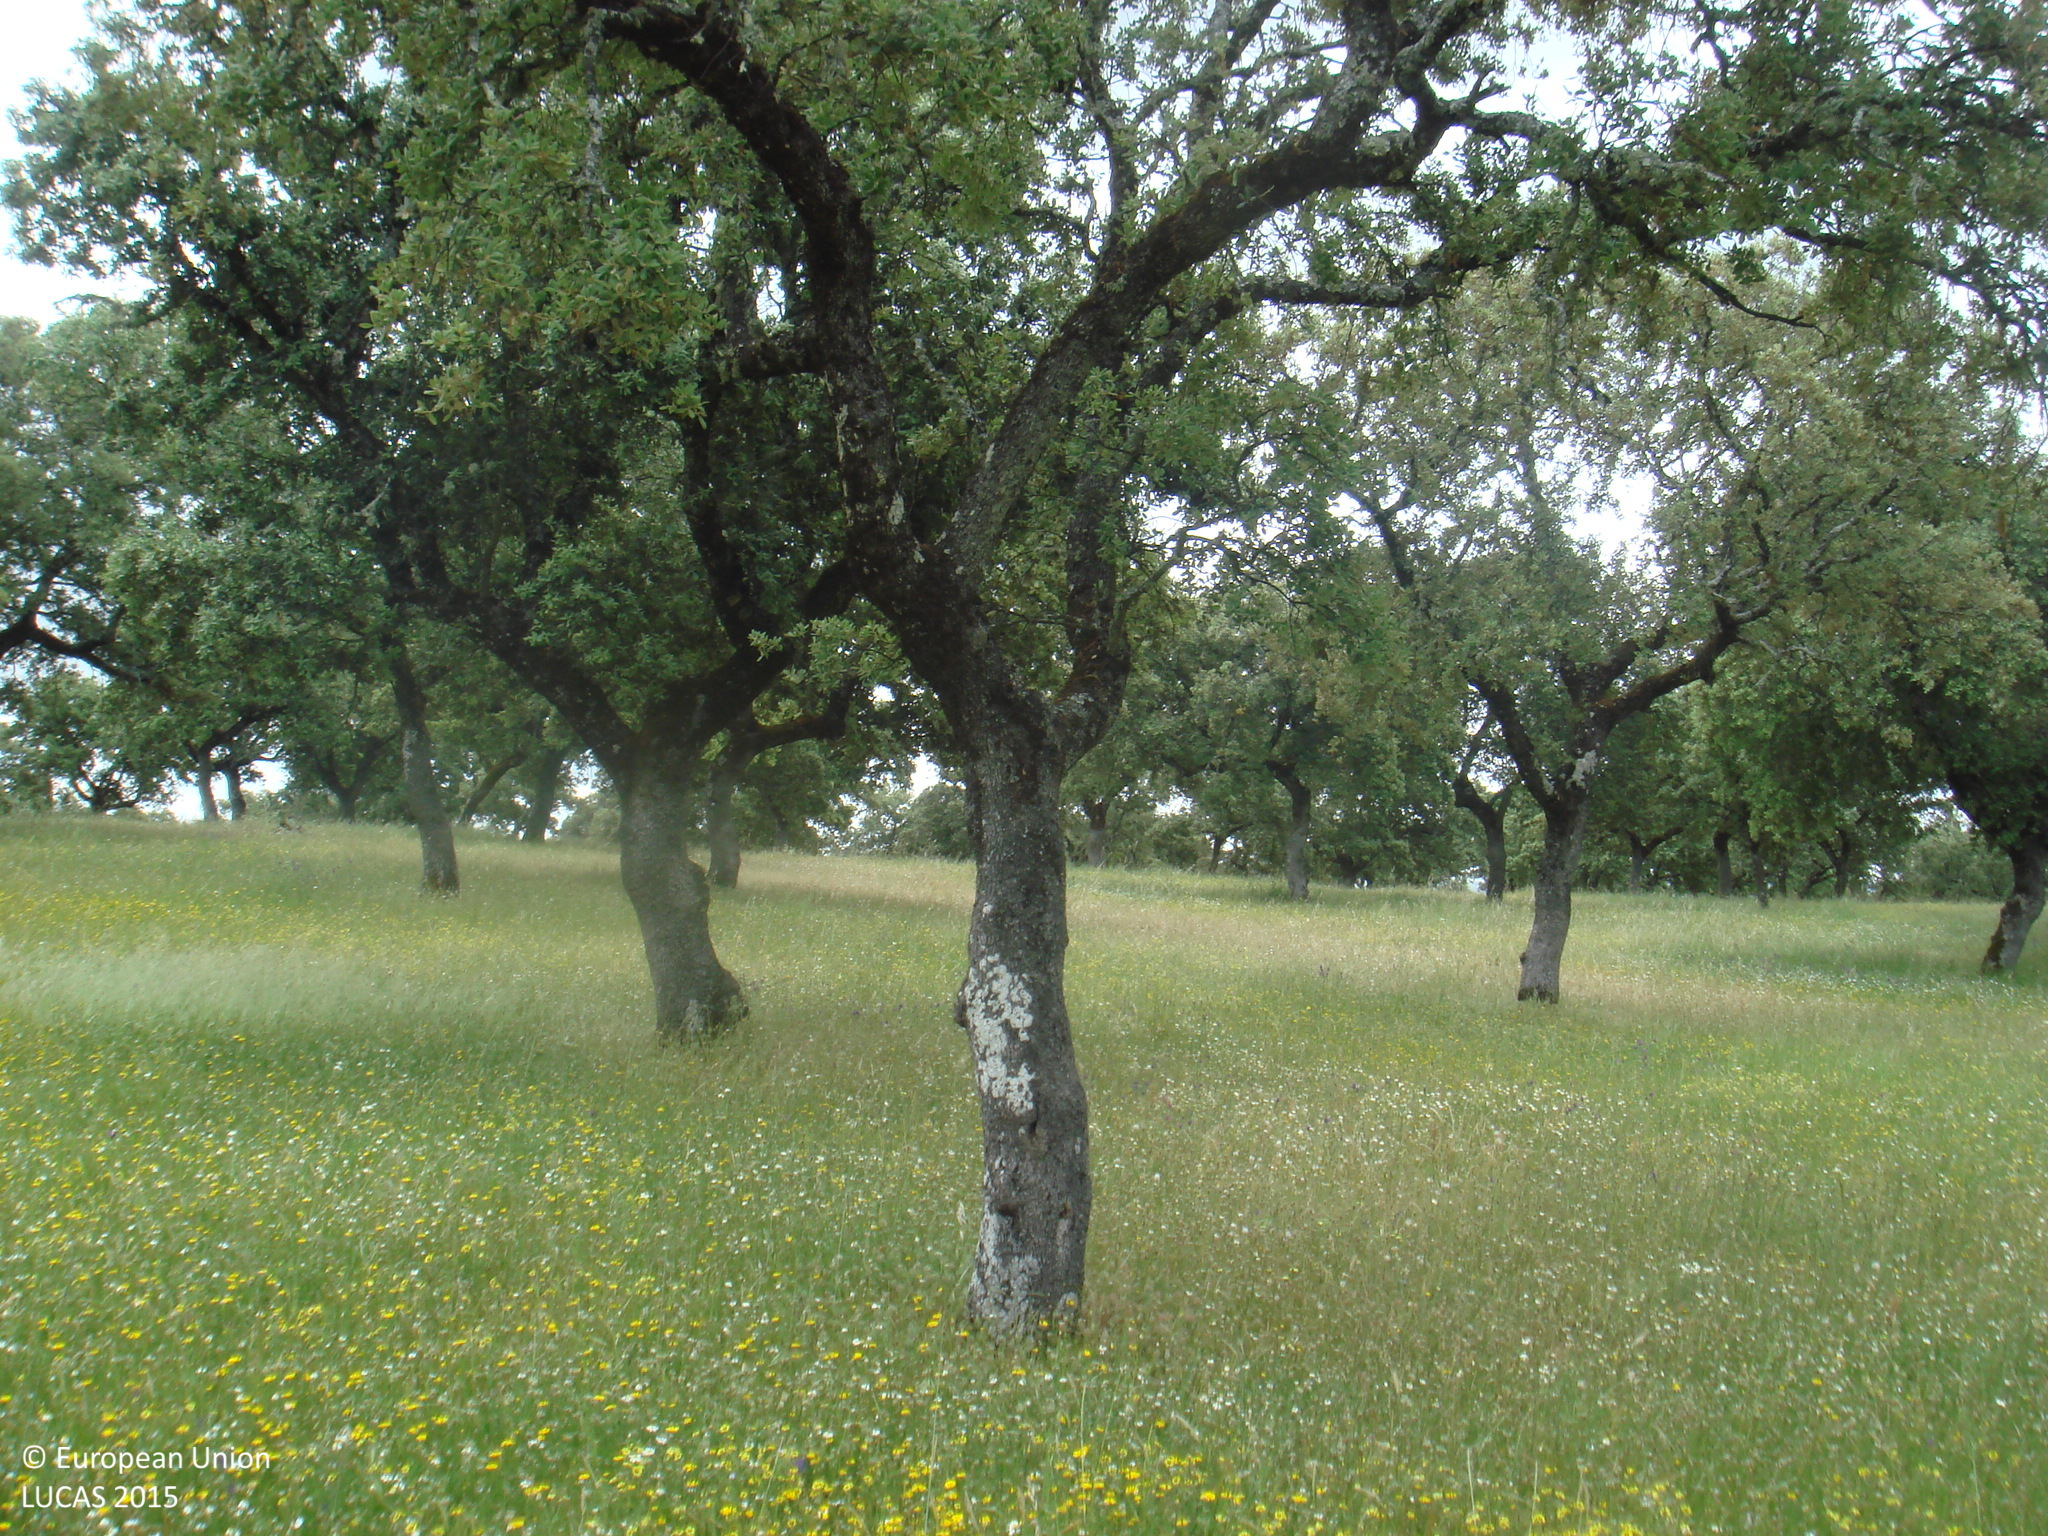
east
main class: Woodland
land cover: Broadleaved woodland
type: broadleaved evergreen forest
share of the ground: 50 - 75 %
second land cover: Grassland without tree/shrub cover
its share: > 75 %
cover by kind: broadleaved forest trees 50 %, herbaceous plants 50 %
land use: Forestry
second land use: Agriculture (excluding fallow land and kitchen gardens)
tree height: > 5 m
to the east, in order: Broadleaved woodland; Grassland without tree/shrub cover; Tracks; Broadleaved woodland; Fences; Broadleaved woodland
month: May
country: ES
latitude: 38.2831
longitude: -4.3858
